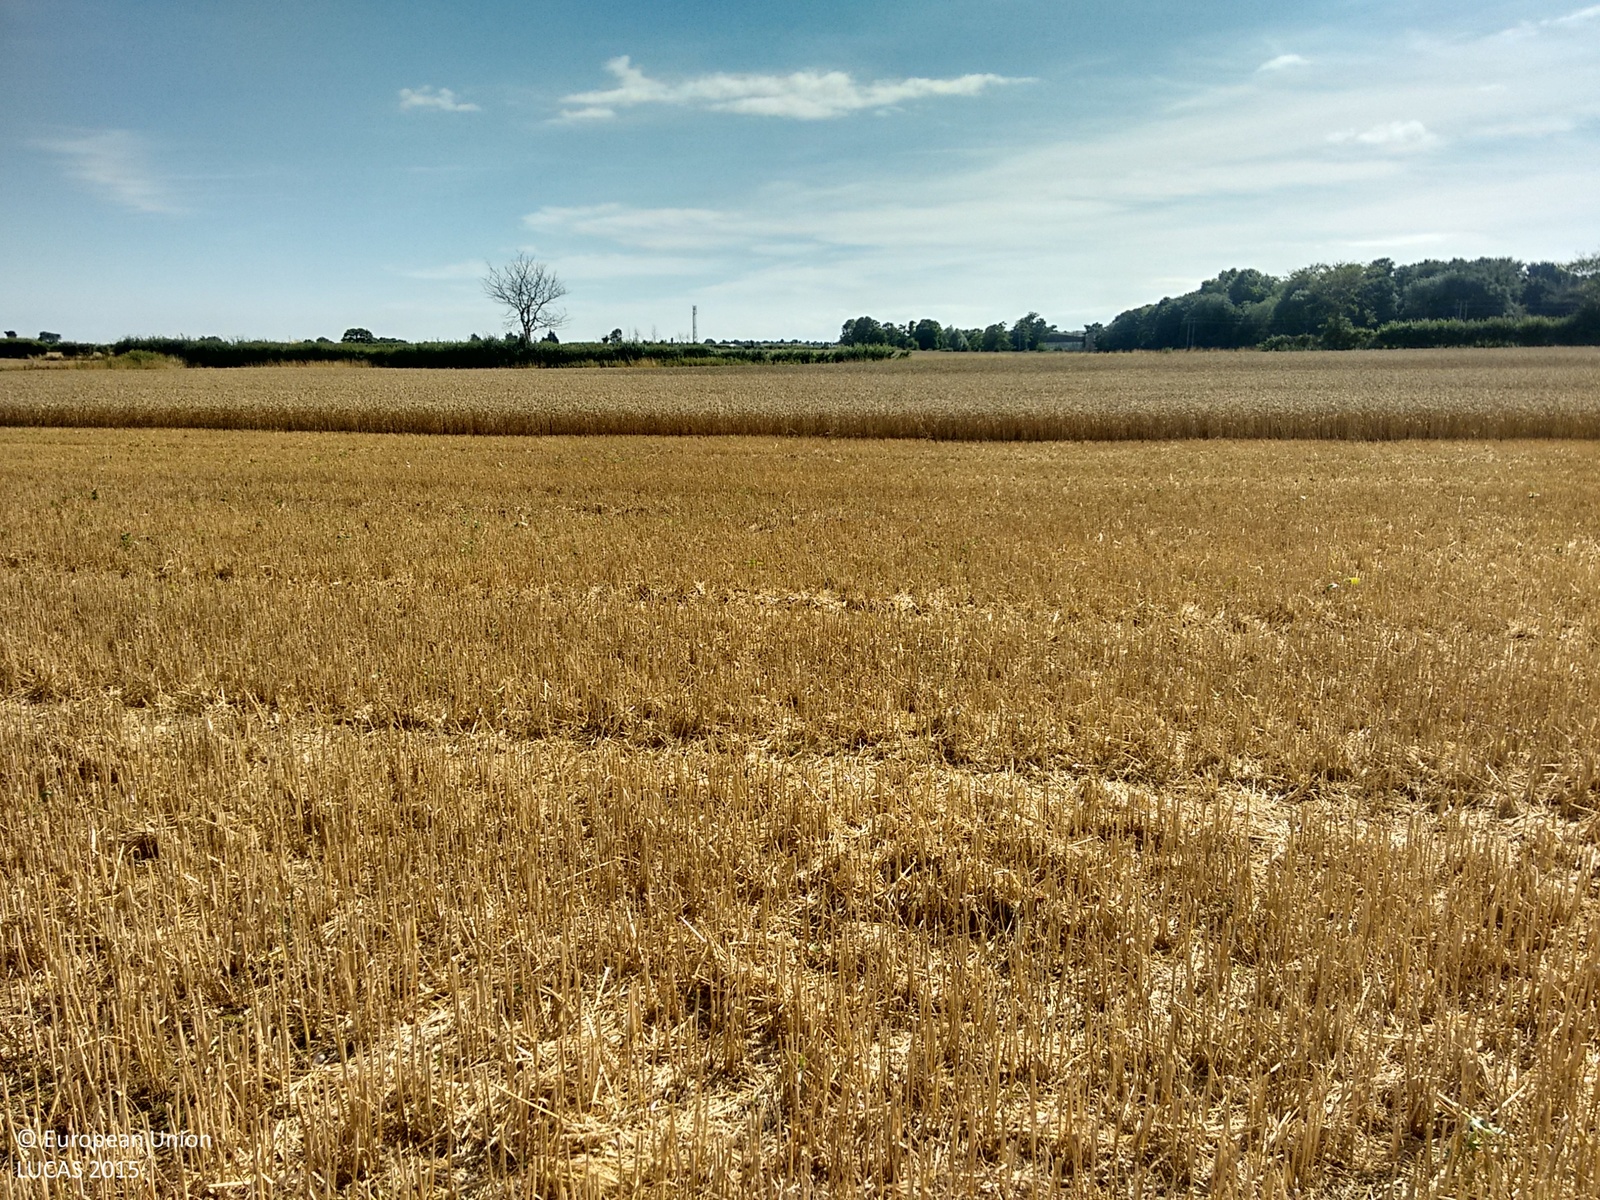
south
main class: Cropland
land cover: Common wheat
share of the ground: > 75 %
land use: Agriculture (excluding fallow land and kitchen gardens)
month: August
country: GB
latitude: 52.1397
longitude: 1.4326
